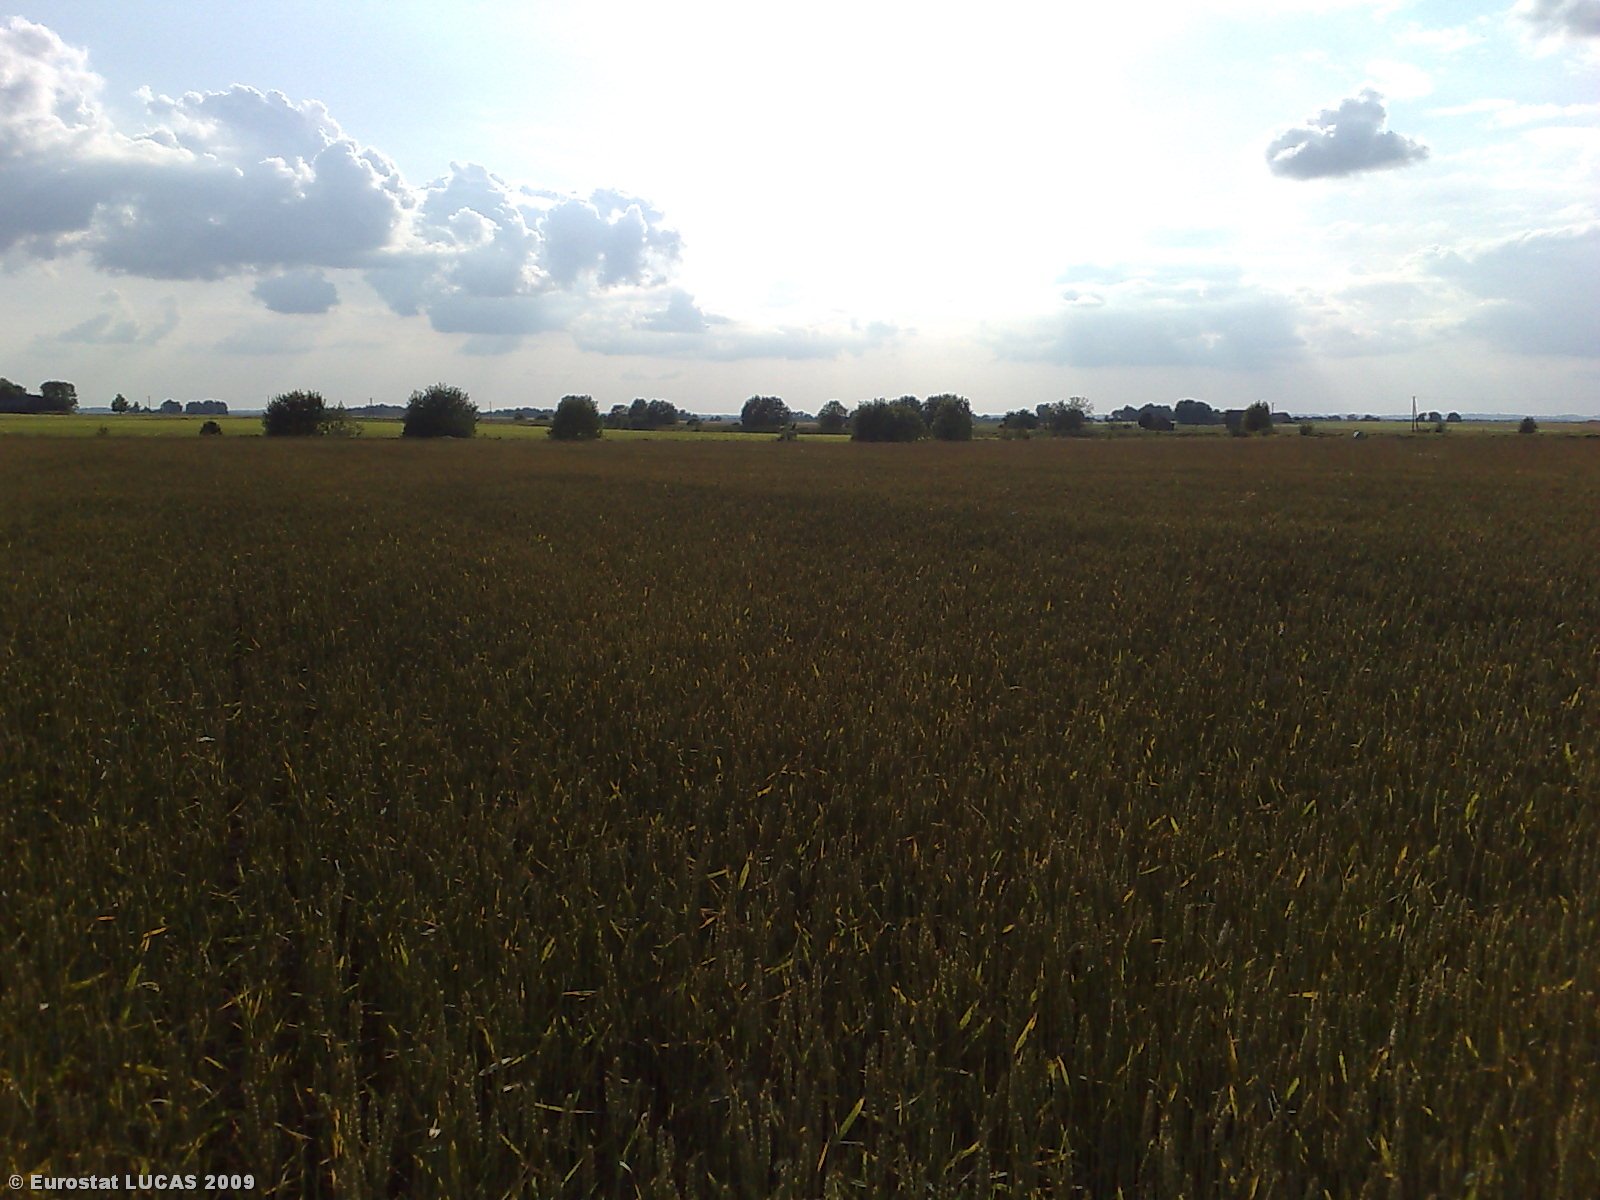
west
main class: Cropland
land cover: Common wheat
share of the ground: > 75 %
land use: Agriculture (excluding fallow land and kitchen gardens)
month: July
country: LT
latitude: 55.7414
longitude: 22.8243
